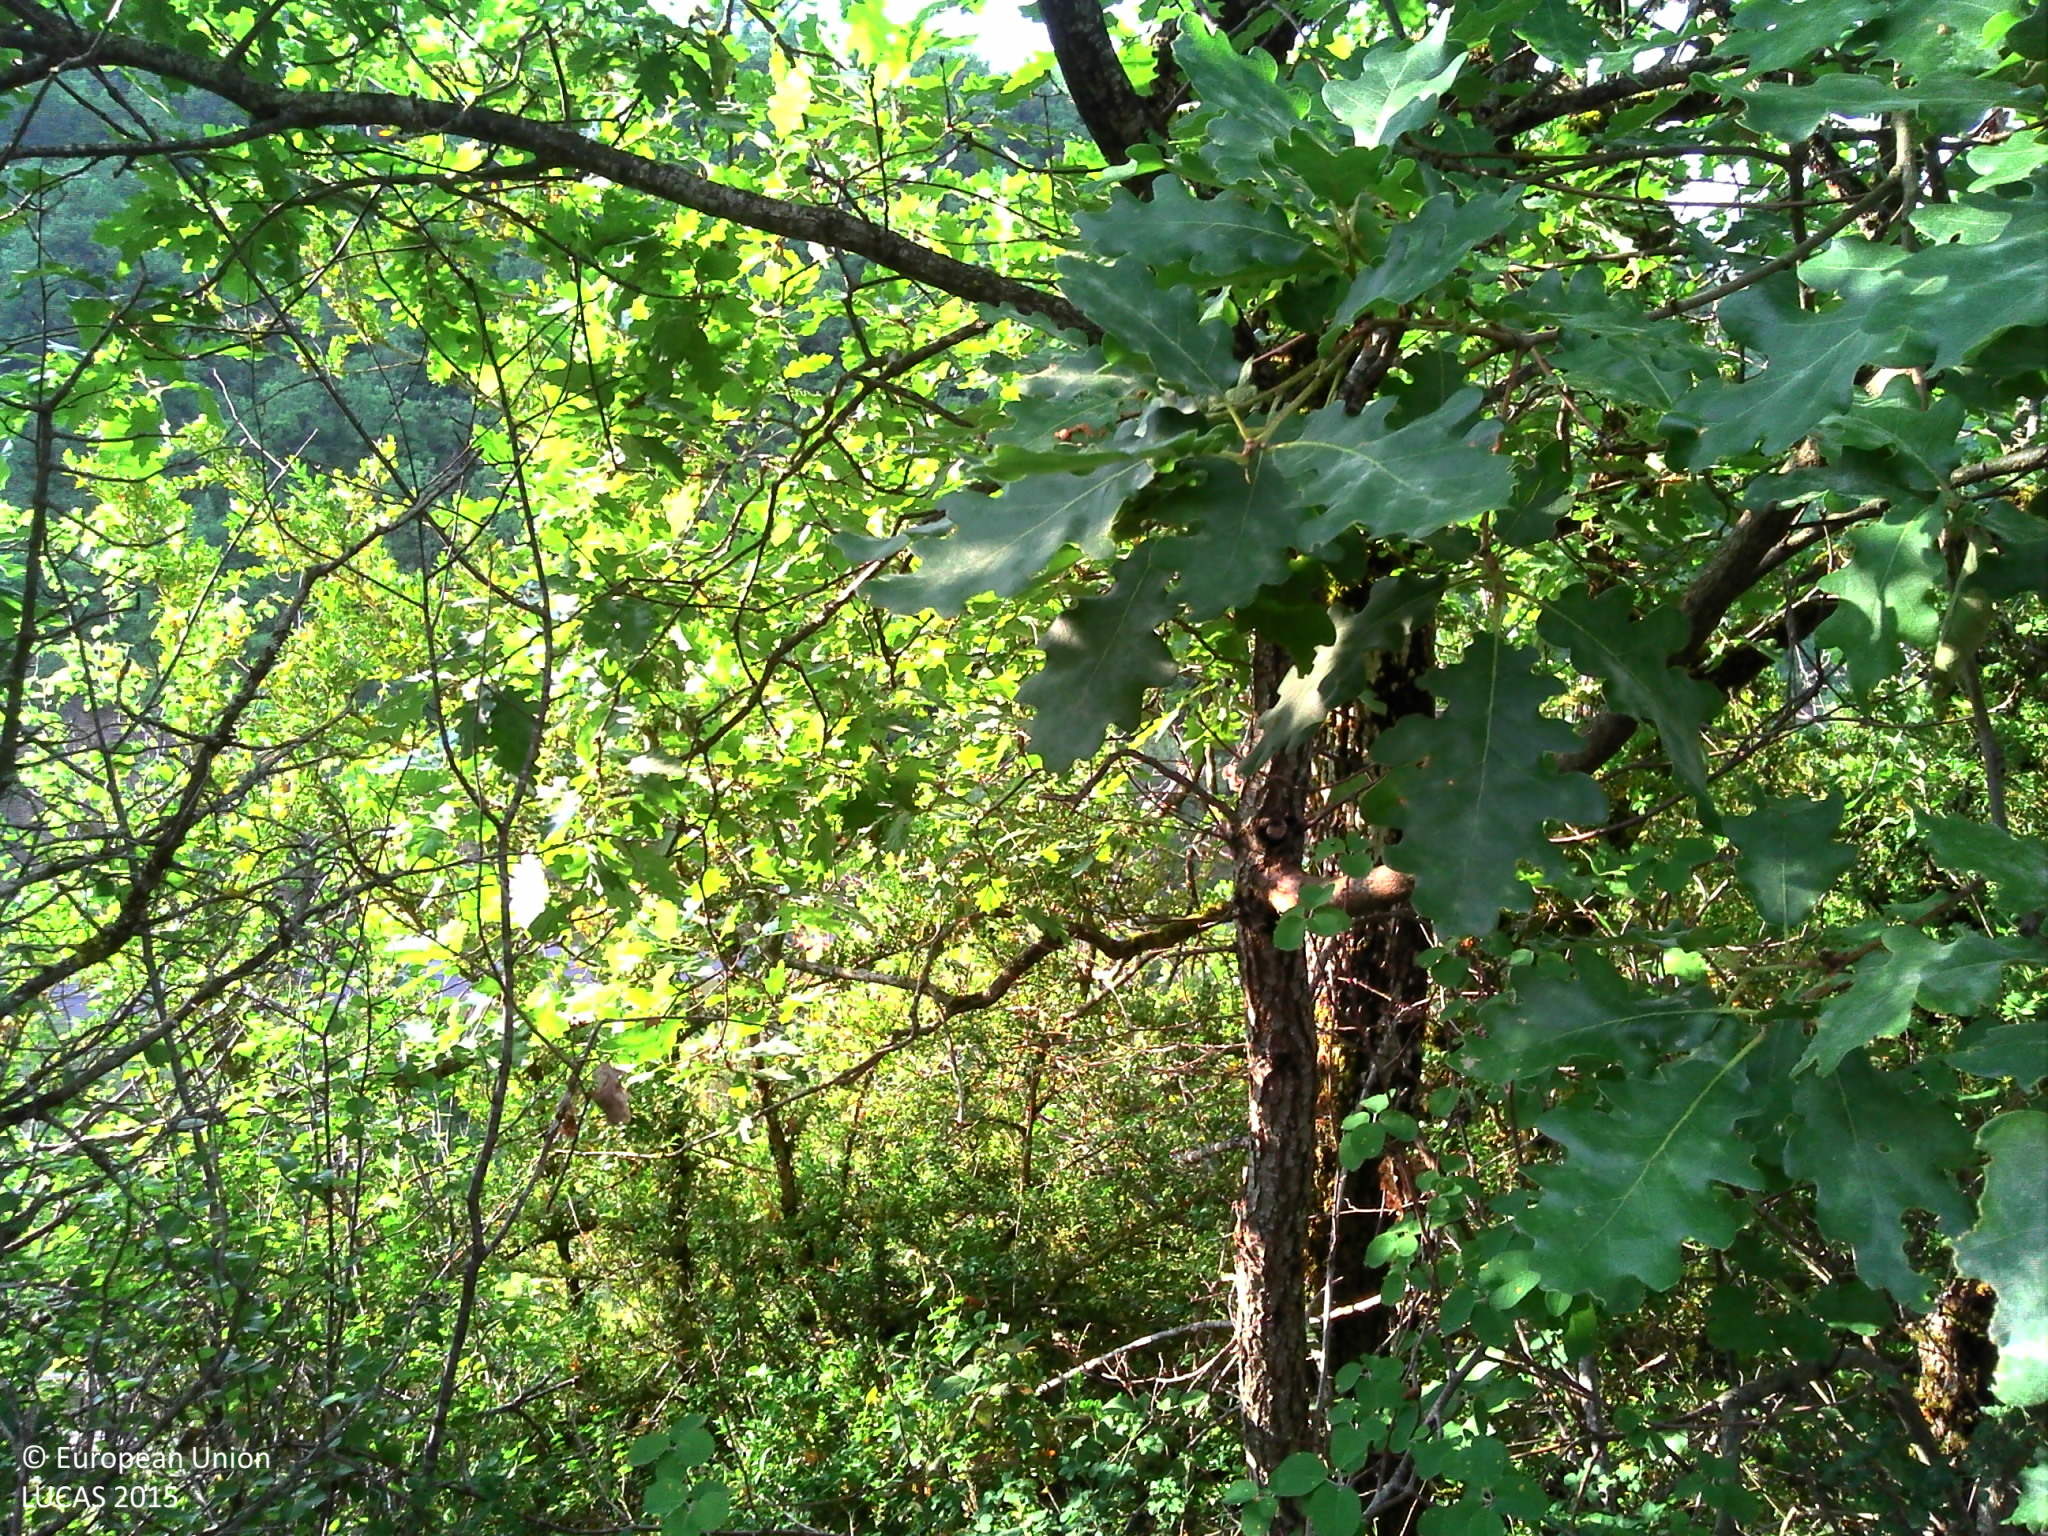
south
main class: Shrubland
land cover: Shrubland with sparse tree cover
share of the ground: > 75 %
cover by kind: shrubs 90 %, broadleaved forest trees 5 %, herbaceous plants 5 %
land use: Semi-natural and natural areas not in use
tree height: < 5 m
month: June
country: FR
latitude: 44.2102
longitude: 3.0846
